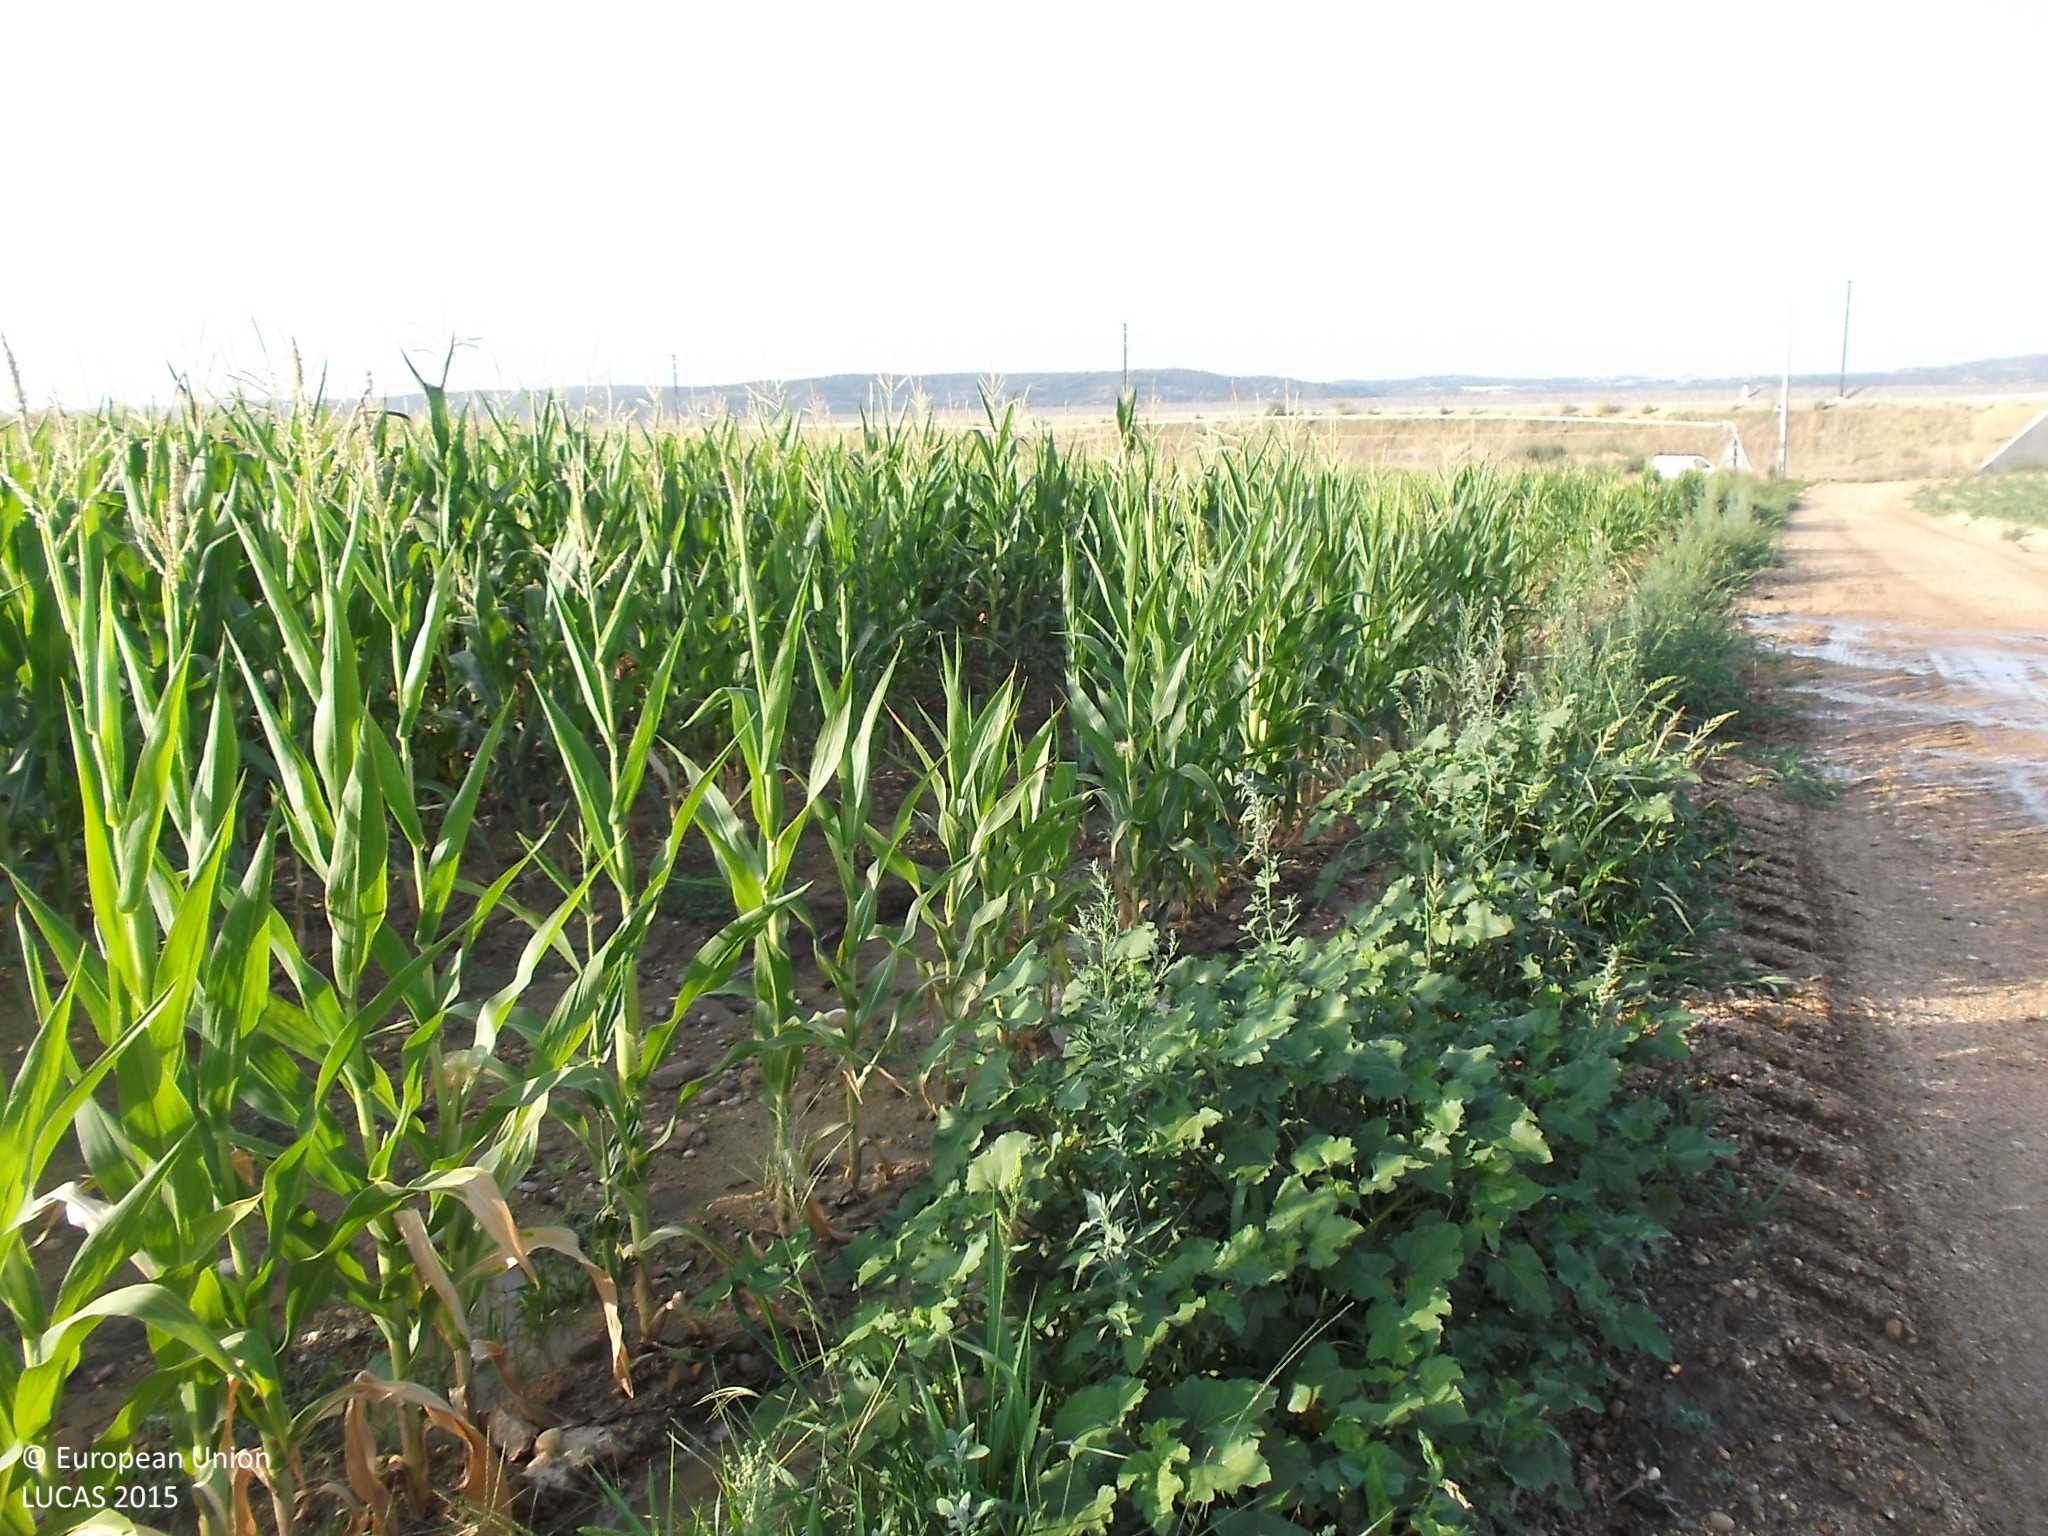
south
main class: Cropland
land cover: Maize
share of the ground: > 75 %
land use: Agriculture (excluding fallow land and kitchen gardens)
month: July
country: ES
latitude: 41.5213
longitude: -5.5290
